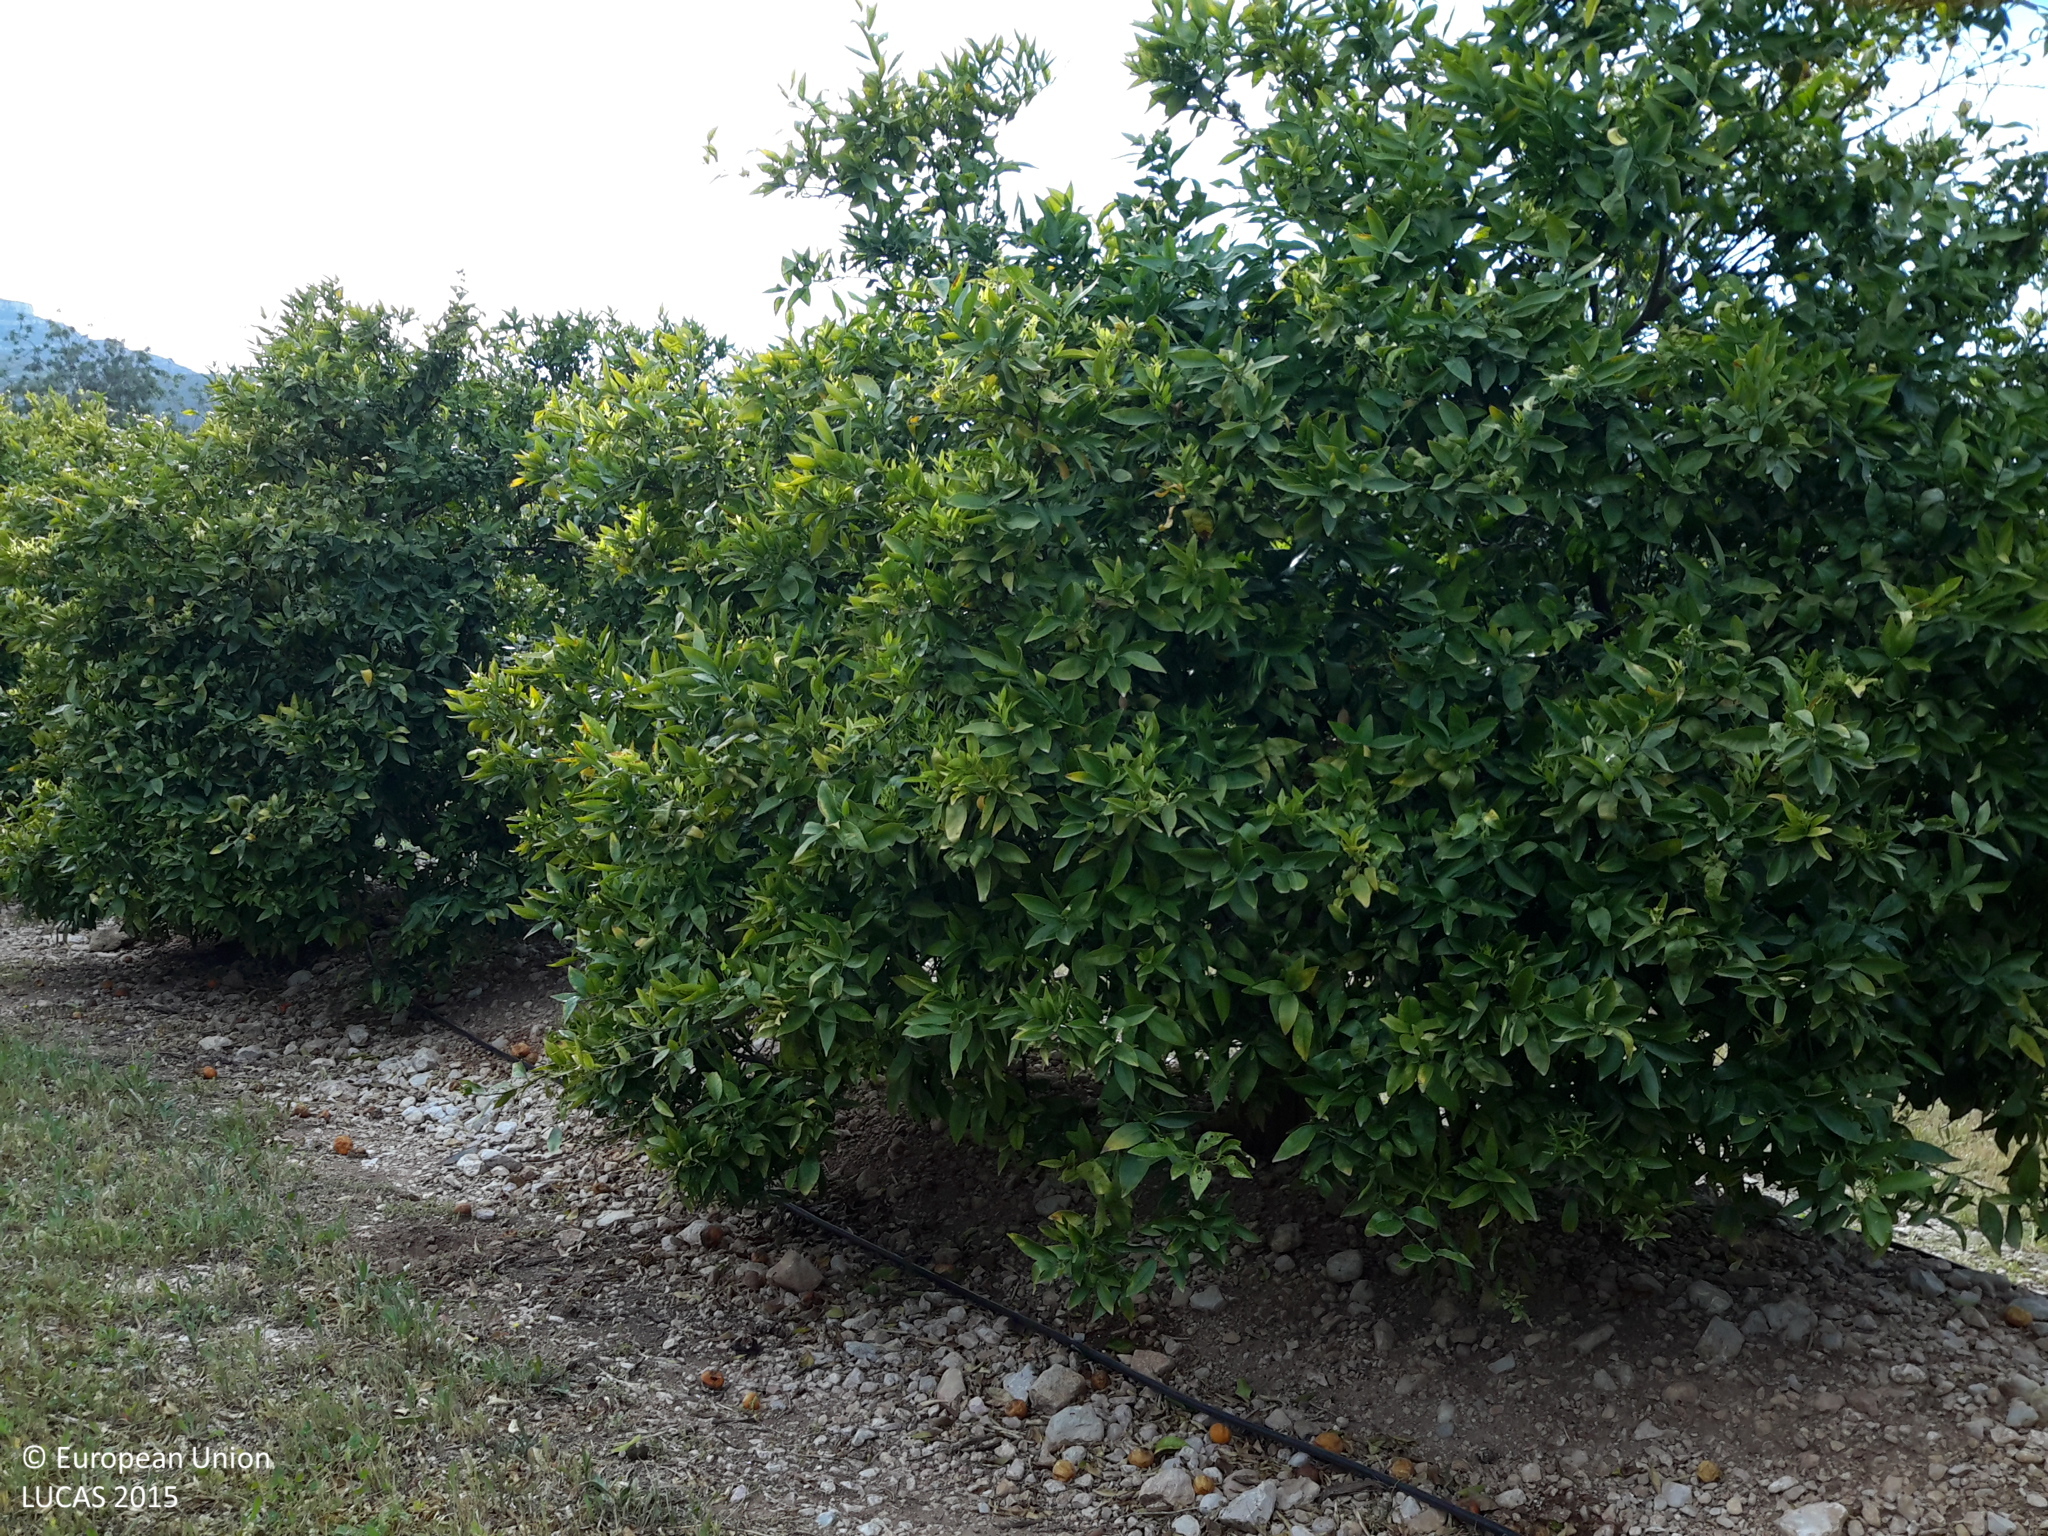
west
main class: Cropland
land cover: Oranges
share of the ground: 25 - 50 %
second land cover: Spontaneously vegetated surfaces
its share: 50 - 75 %
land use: Agriculture (excluding fallow land and kitchen gardens)
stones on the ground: > 50 %
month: April
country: ES
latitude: 40.6674
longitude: 0.5674
